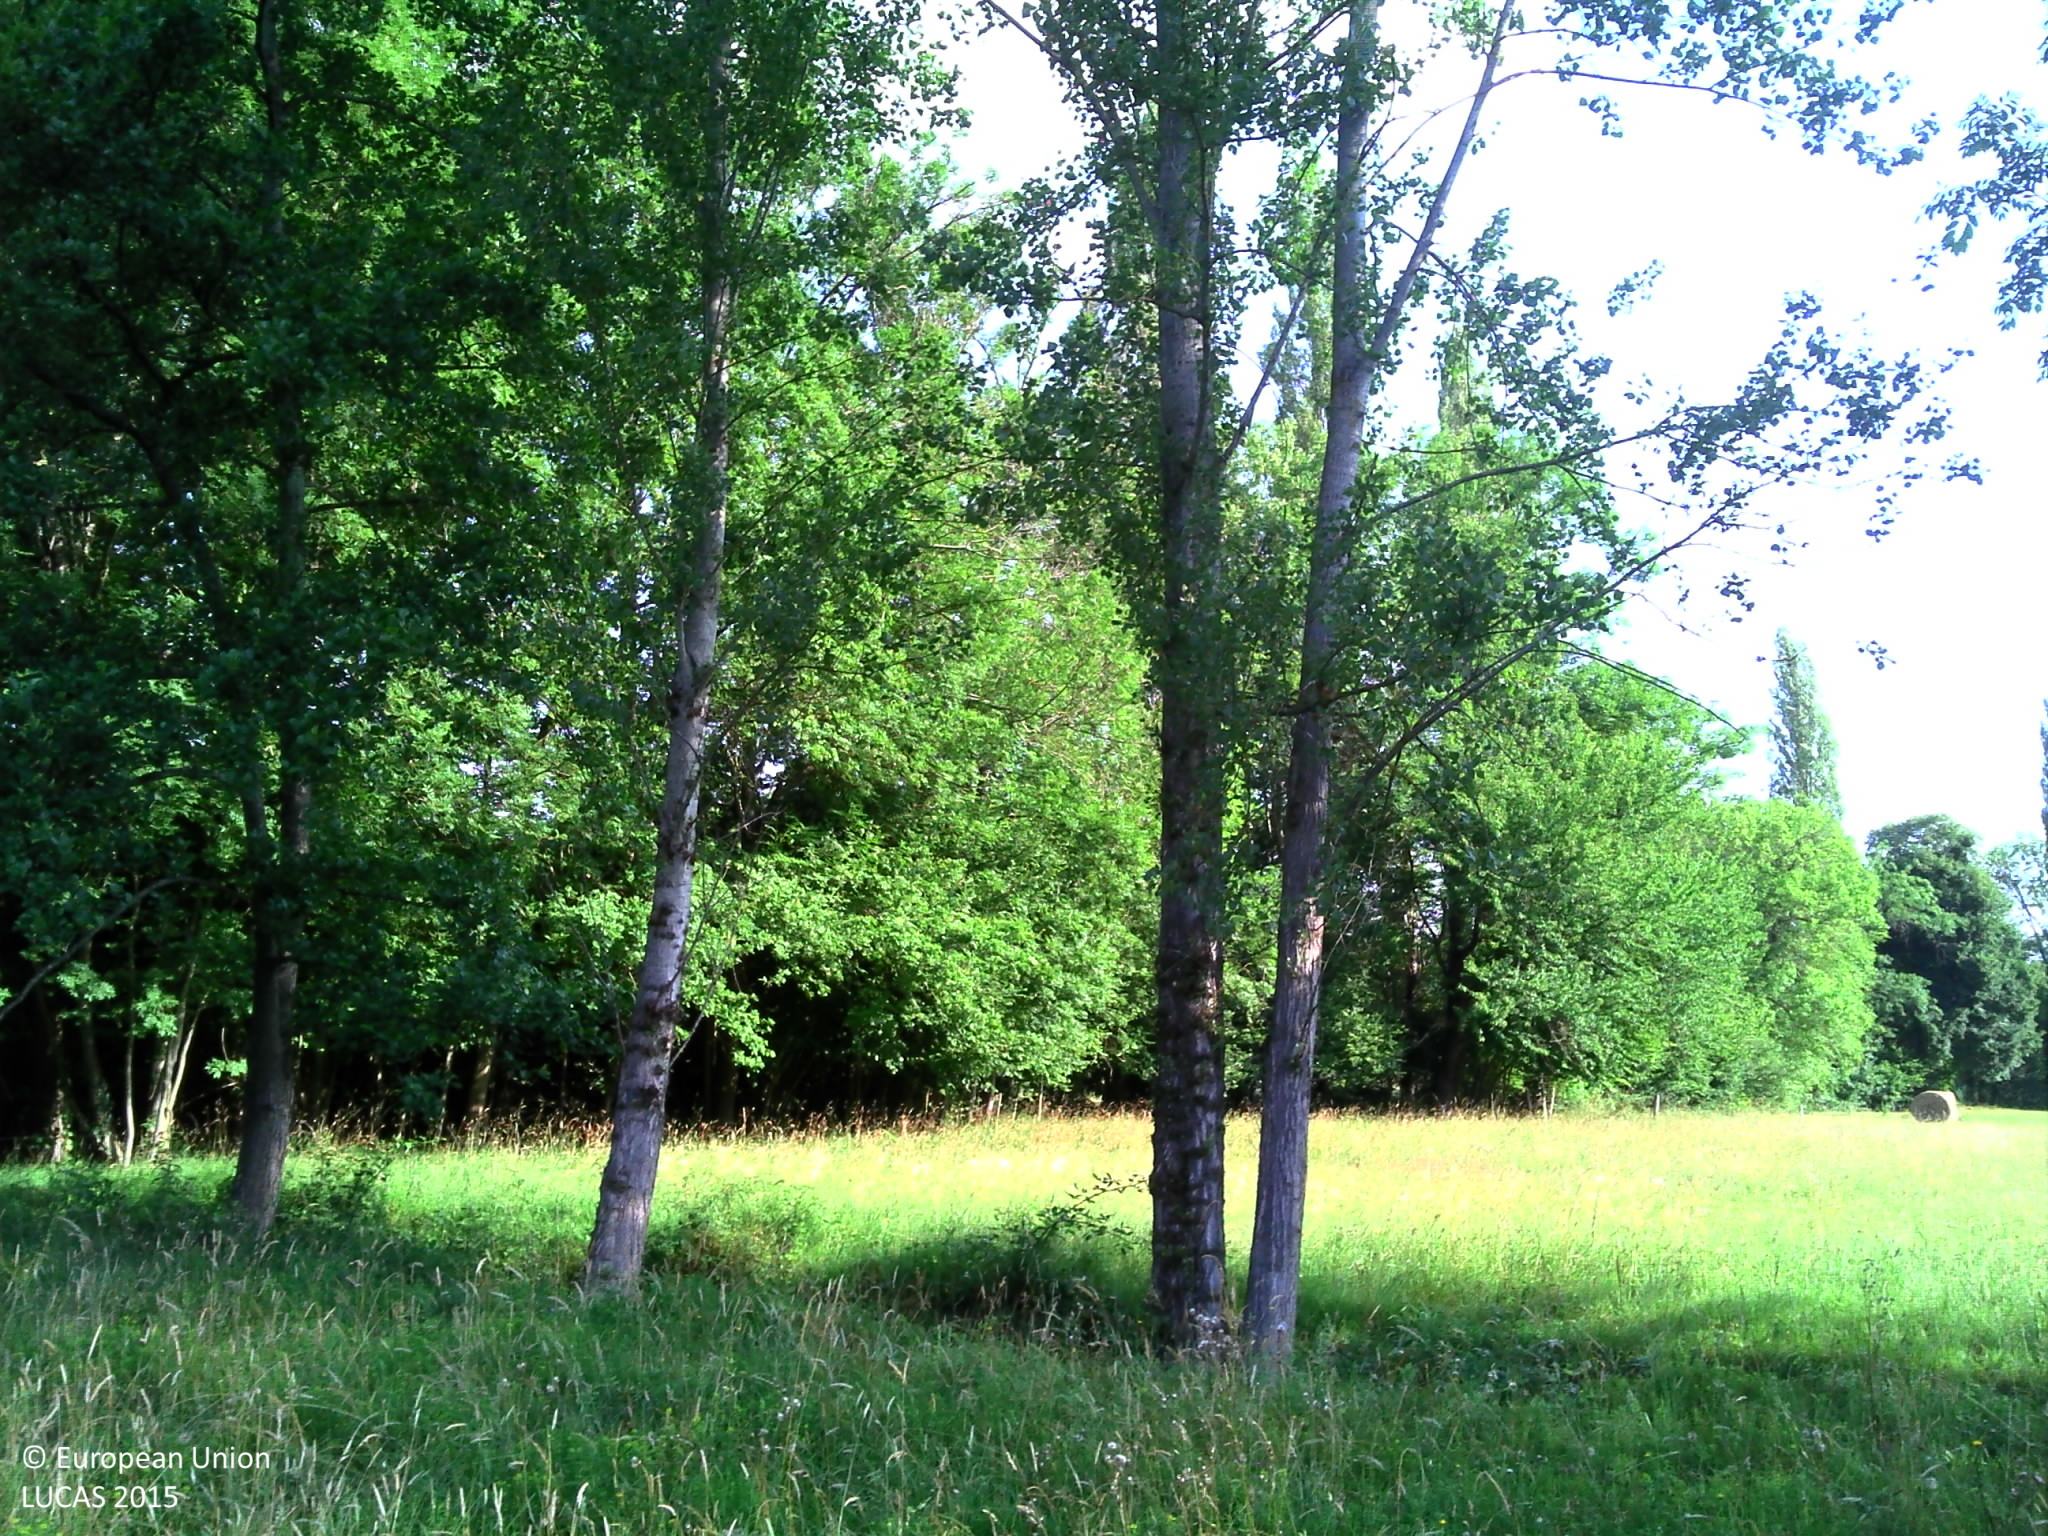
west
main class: Grassland
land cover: Grassland without tree/shrub cover
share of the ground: > 75 %
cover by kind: herbaceous plants 100 %
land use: Agriculture (excluding fallow land and kitchen gardens)
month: July
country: FR
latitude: 42.9889
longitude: 1.1128
